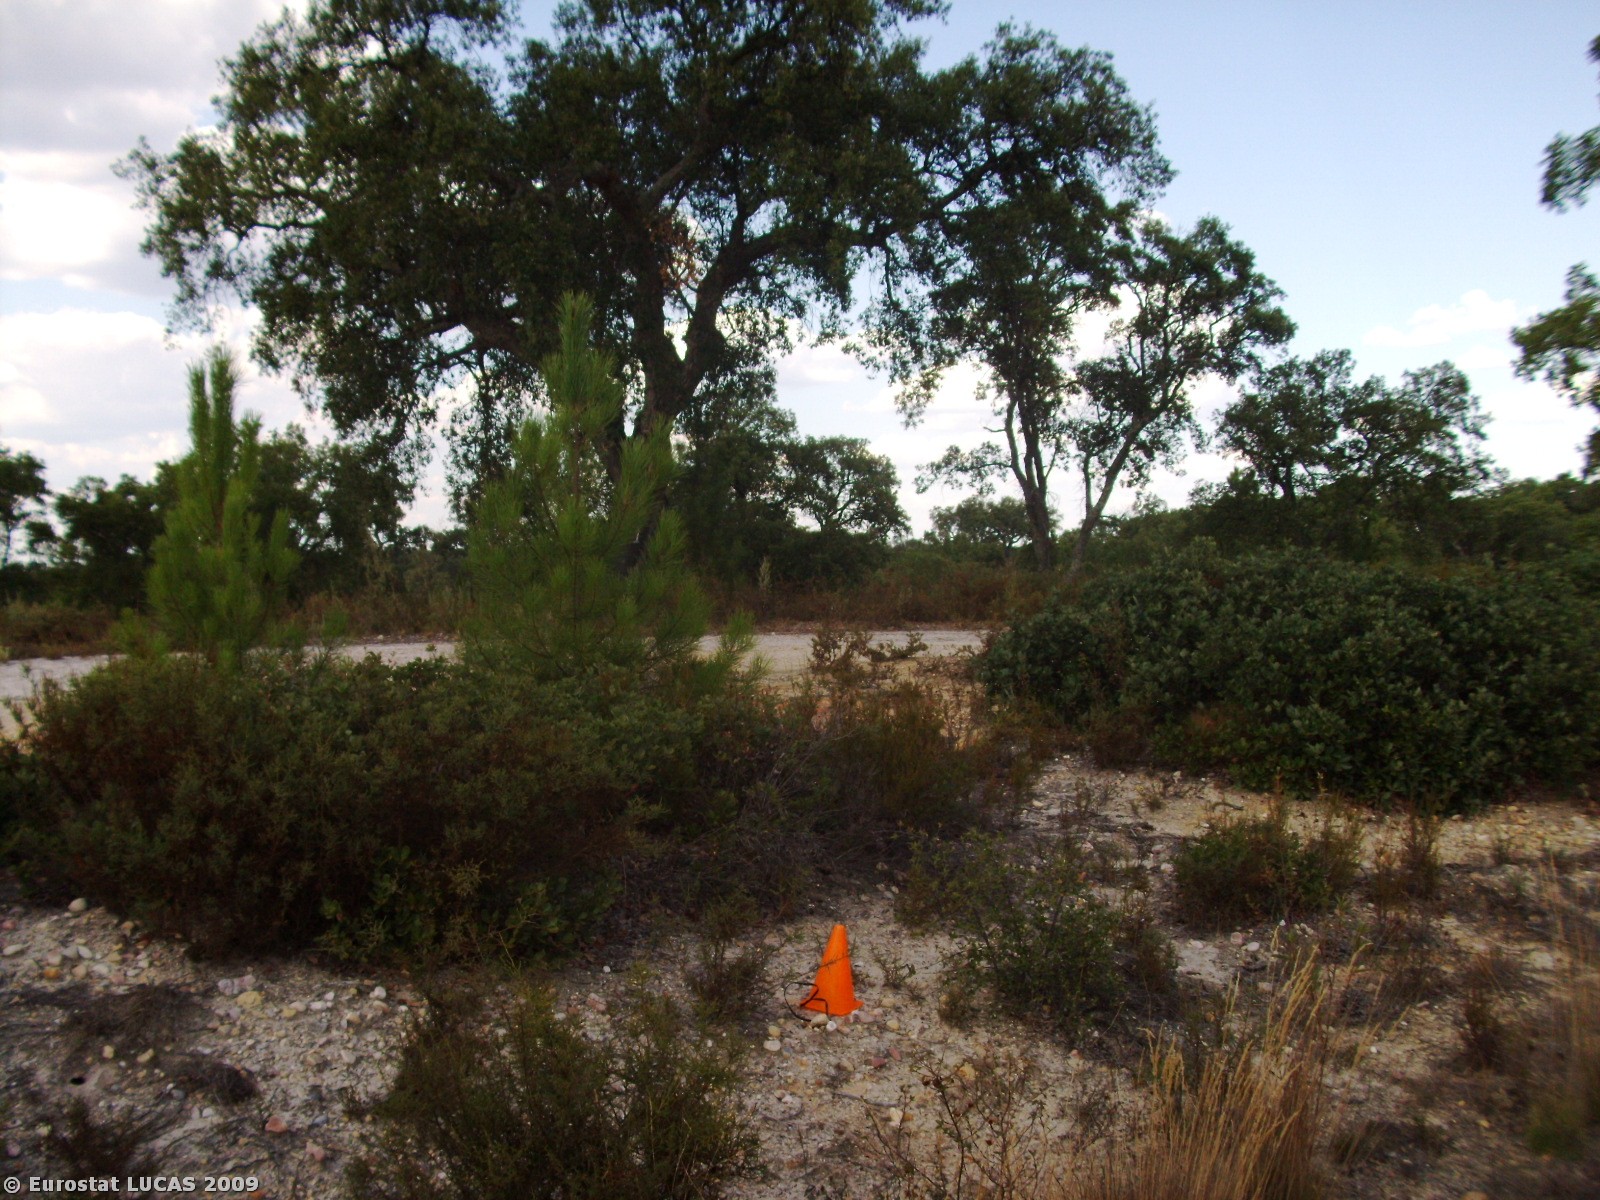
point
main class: Woodland
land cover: Mixed woodland
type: hemiboreal forest and nemoral coniferous forest and mixed broadleaved-coniferous forest
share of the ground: 10 - 25 %
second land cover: Spontaneously vegetated surfaces
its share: 50 - 75 %
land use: Forestry
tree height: > 5 m
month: August
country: PT
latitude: 39.1951
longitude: -8.1073
